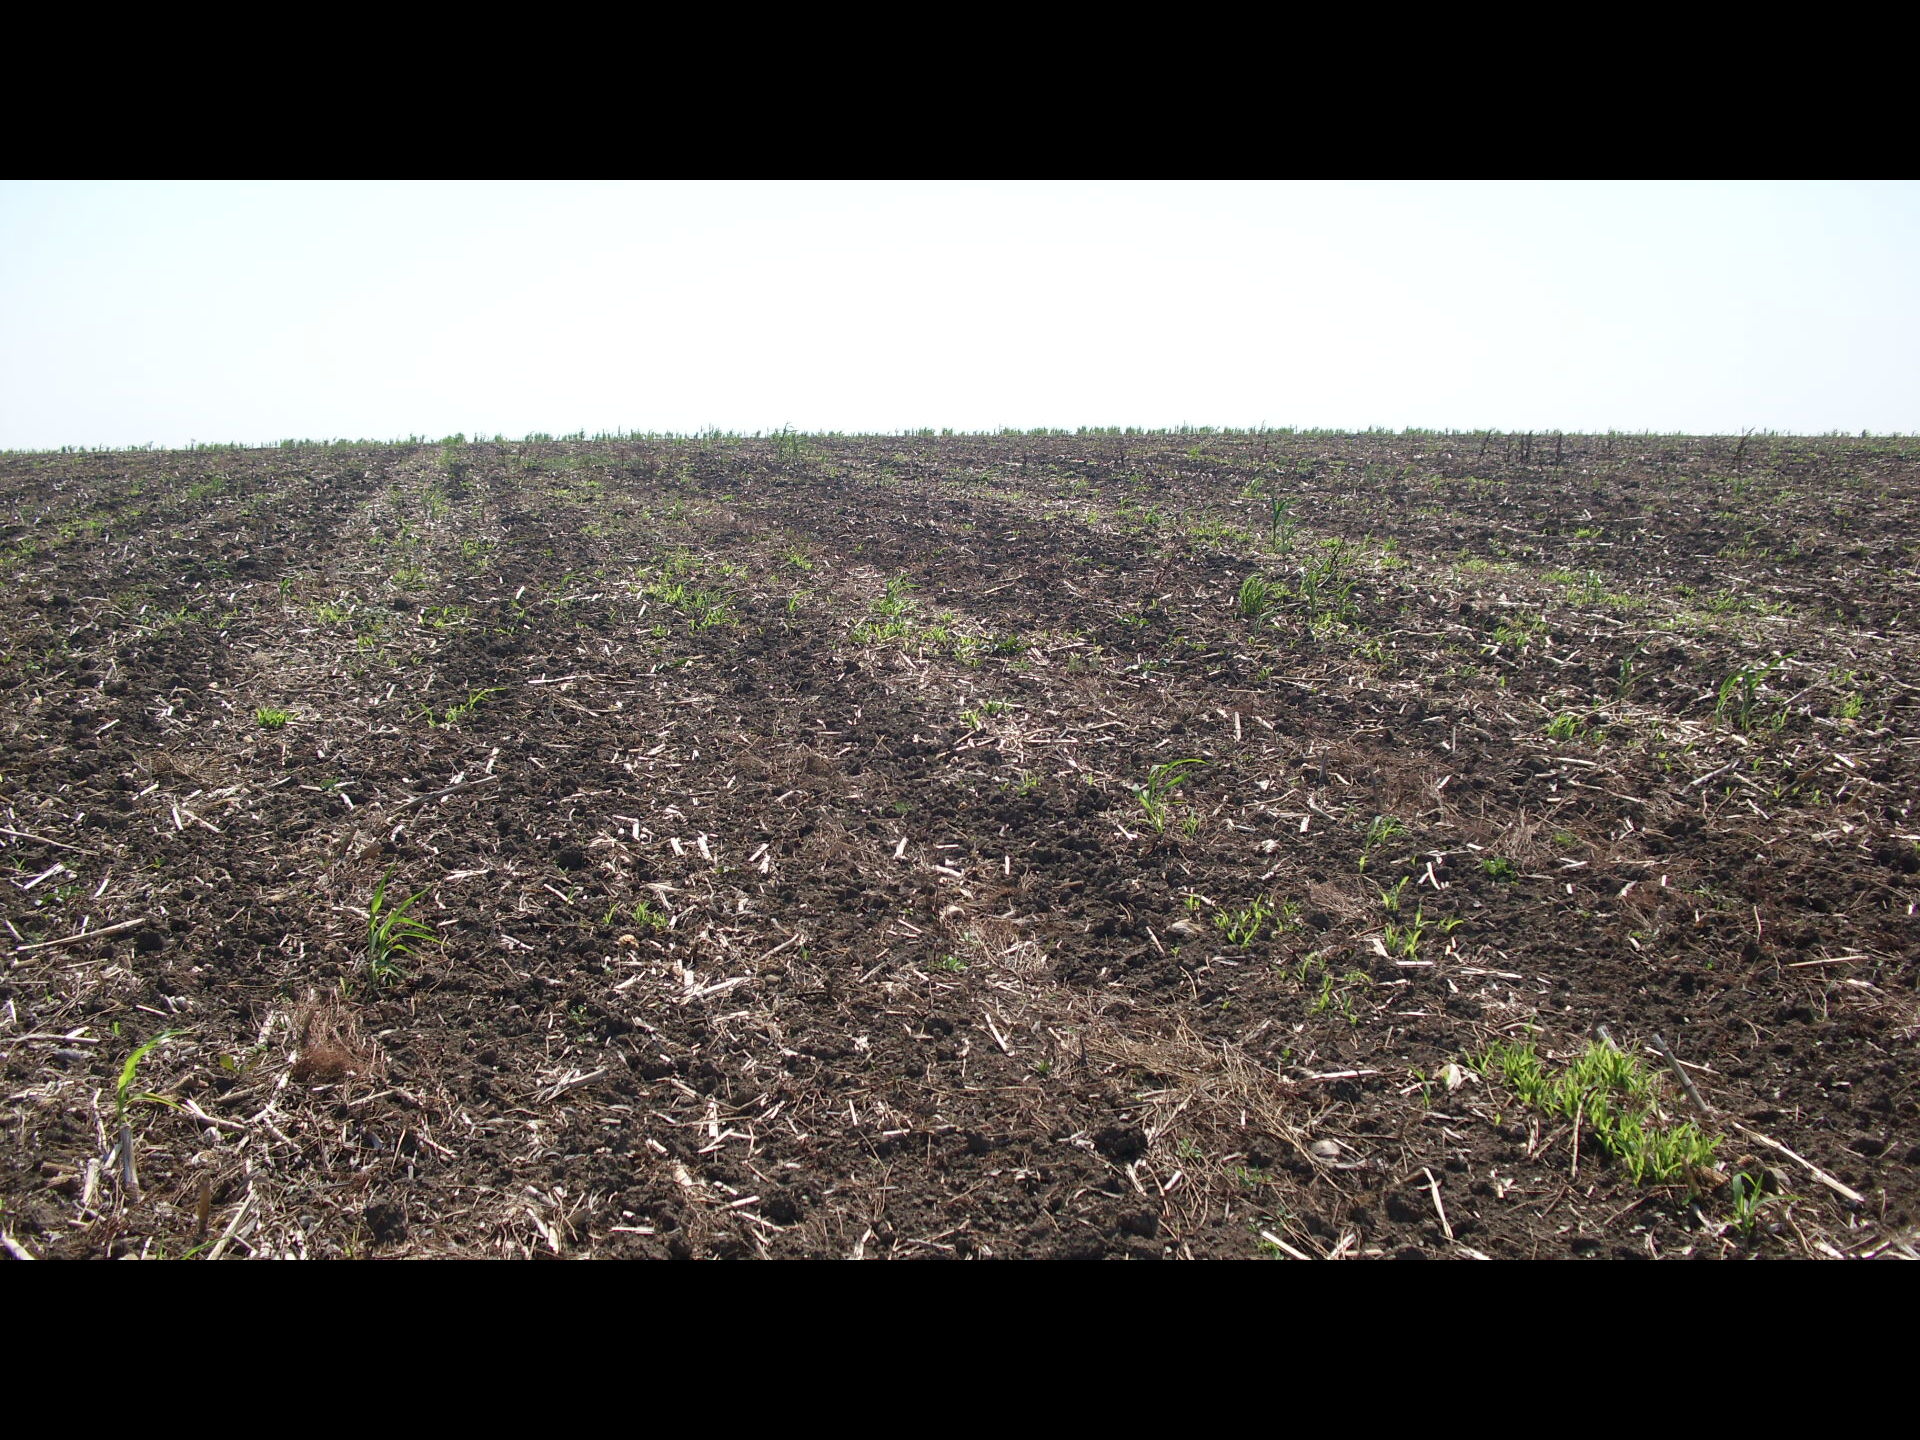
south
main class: Cropland
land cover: Maize
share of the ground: < 10 %
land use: Agriculture (excluding fallow land and kitchen gardens)
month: September
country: BG
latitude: 43.9906
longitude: 22.5160
